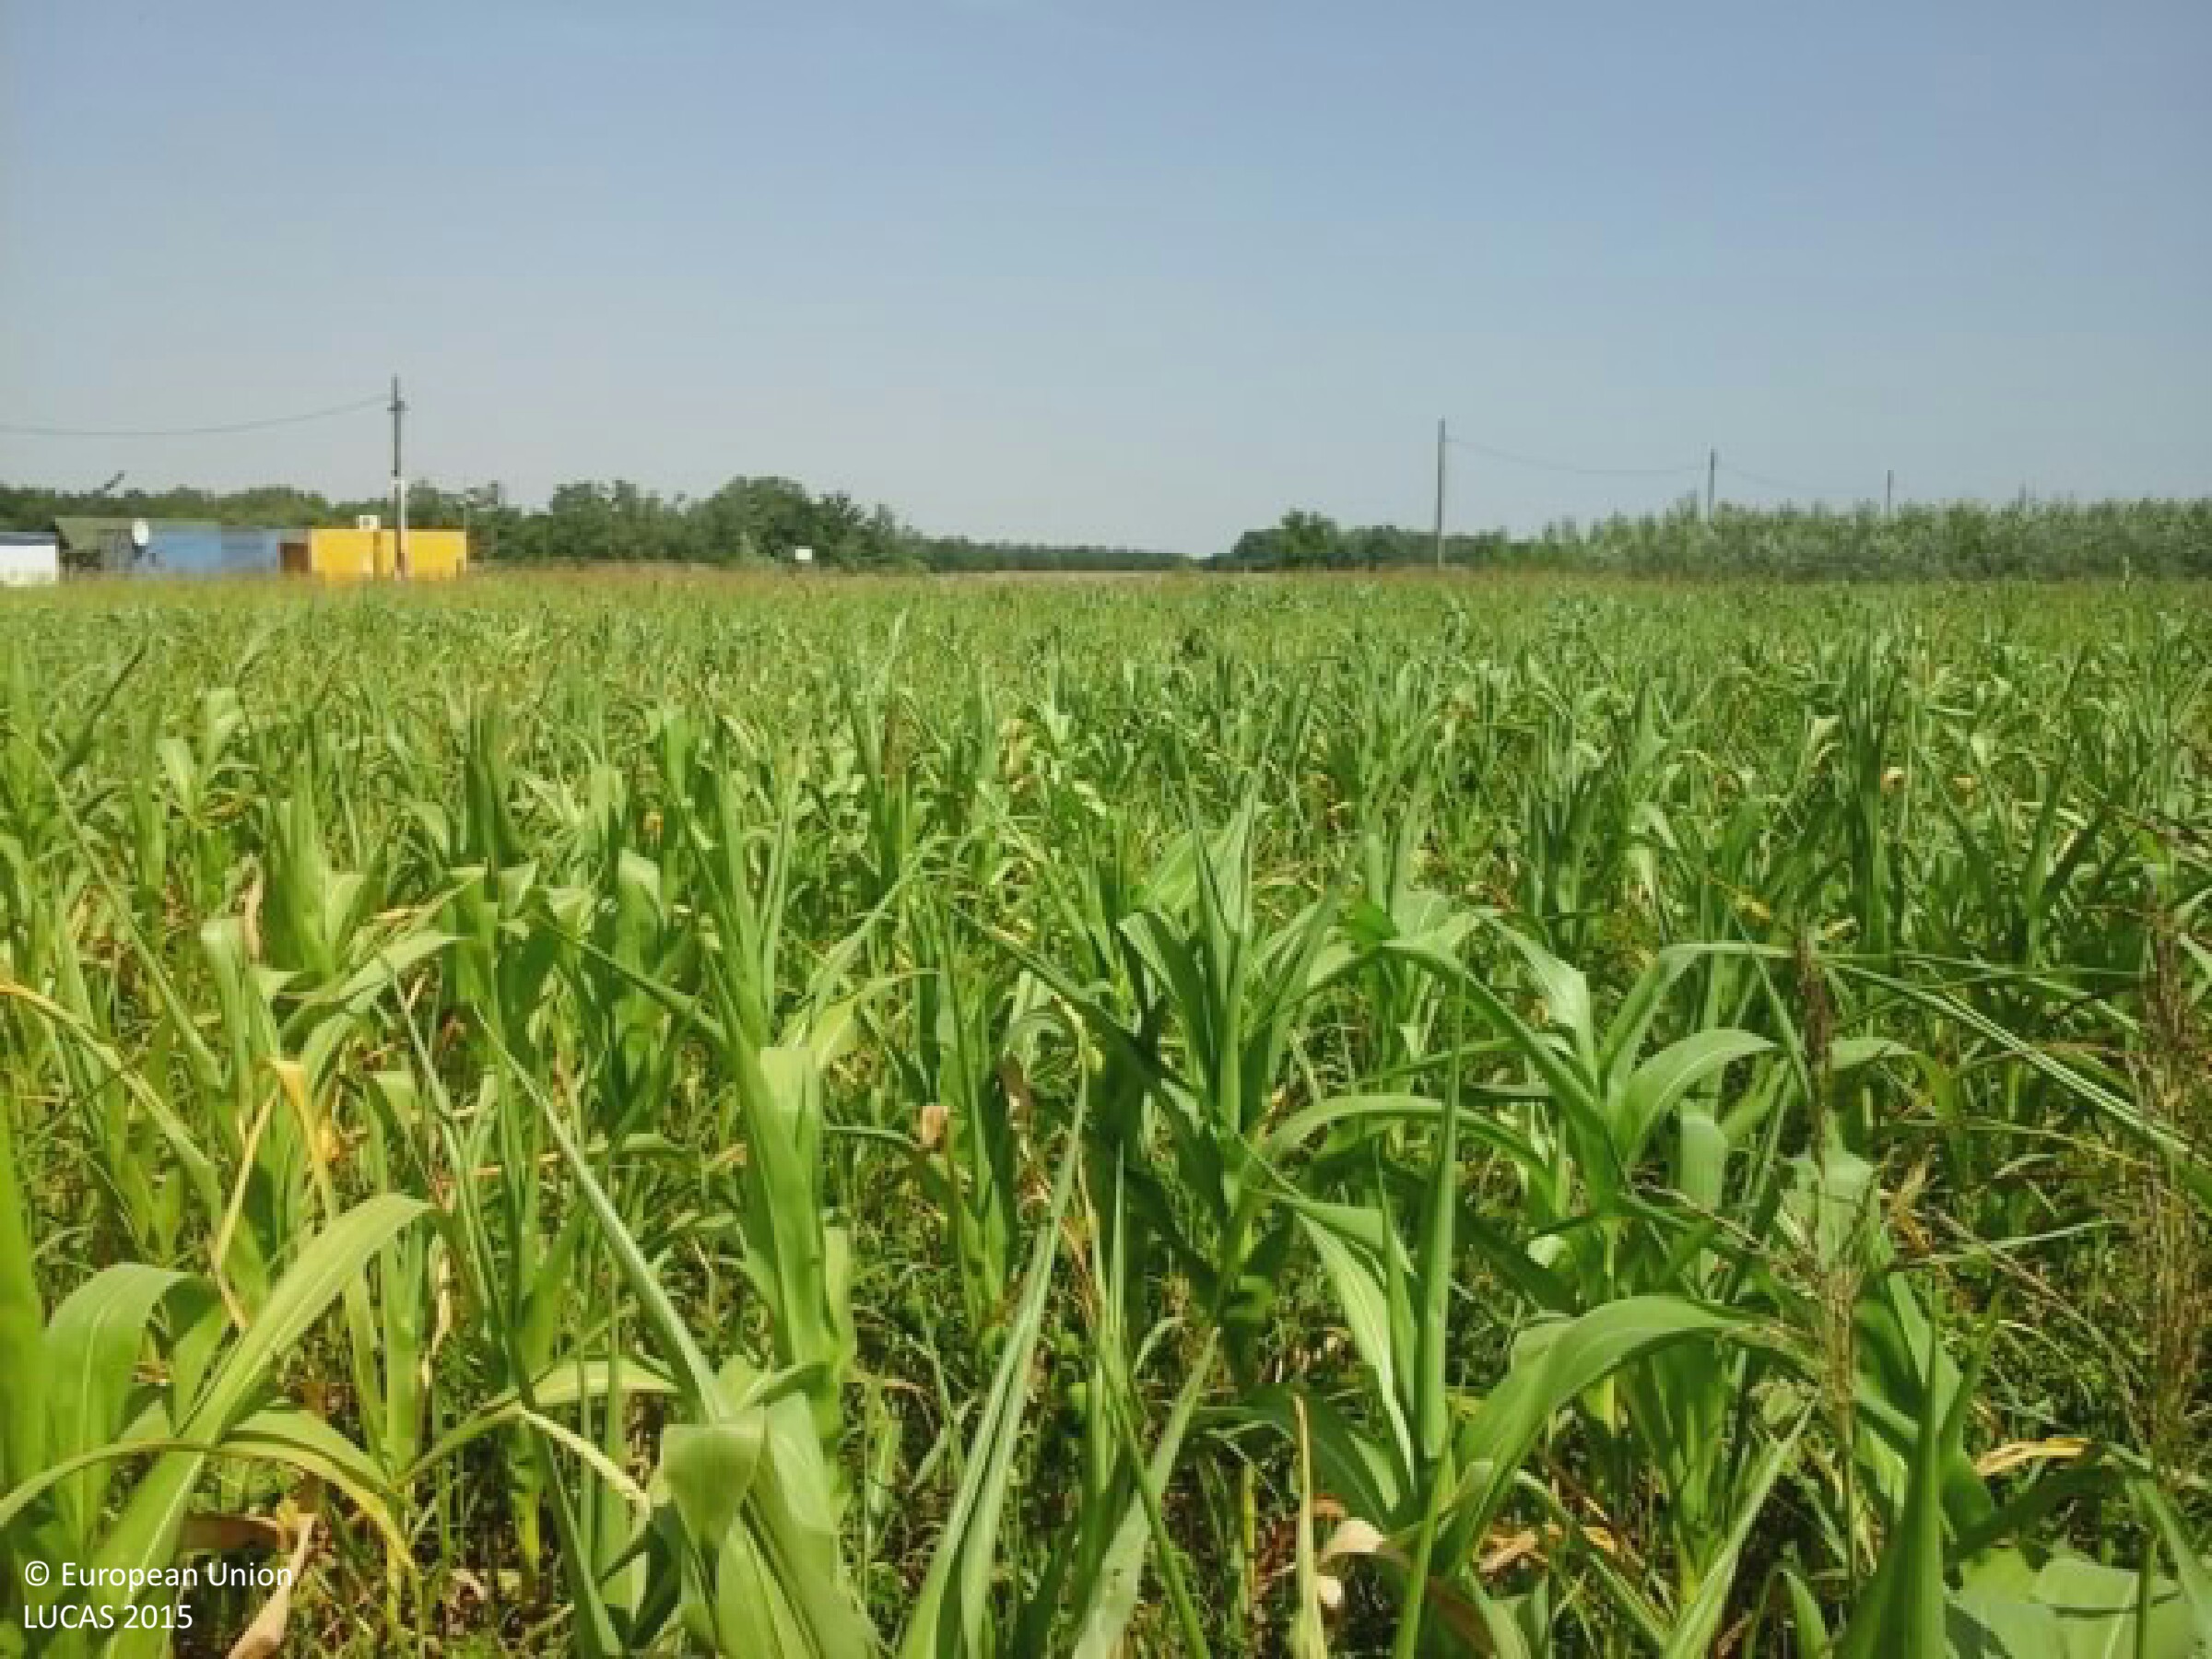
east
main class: Cropland
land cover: Maize
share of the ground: 50 - 75 %
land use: Agriculture (excluding fallow land and kitchen gardens)
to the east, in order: Maize; Grass margins; Tracks; Spontaneously vegetated surfaces; Inland fresh water bodies; Spontaneously vegetated surfaces
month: July
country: HU
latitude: 47.2315
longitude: 19.0912
